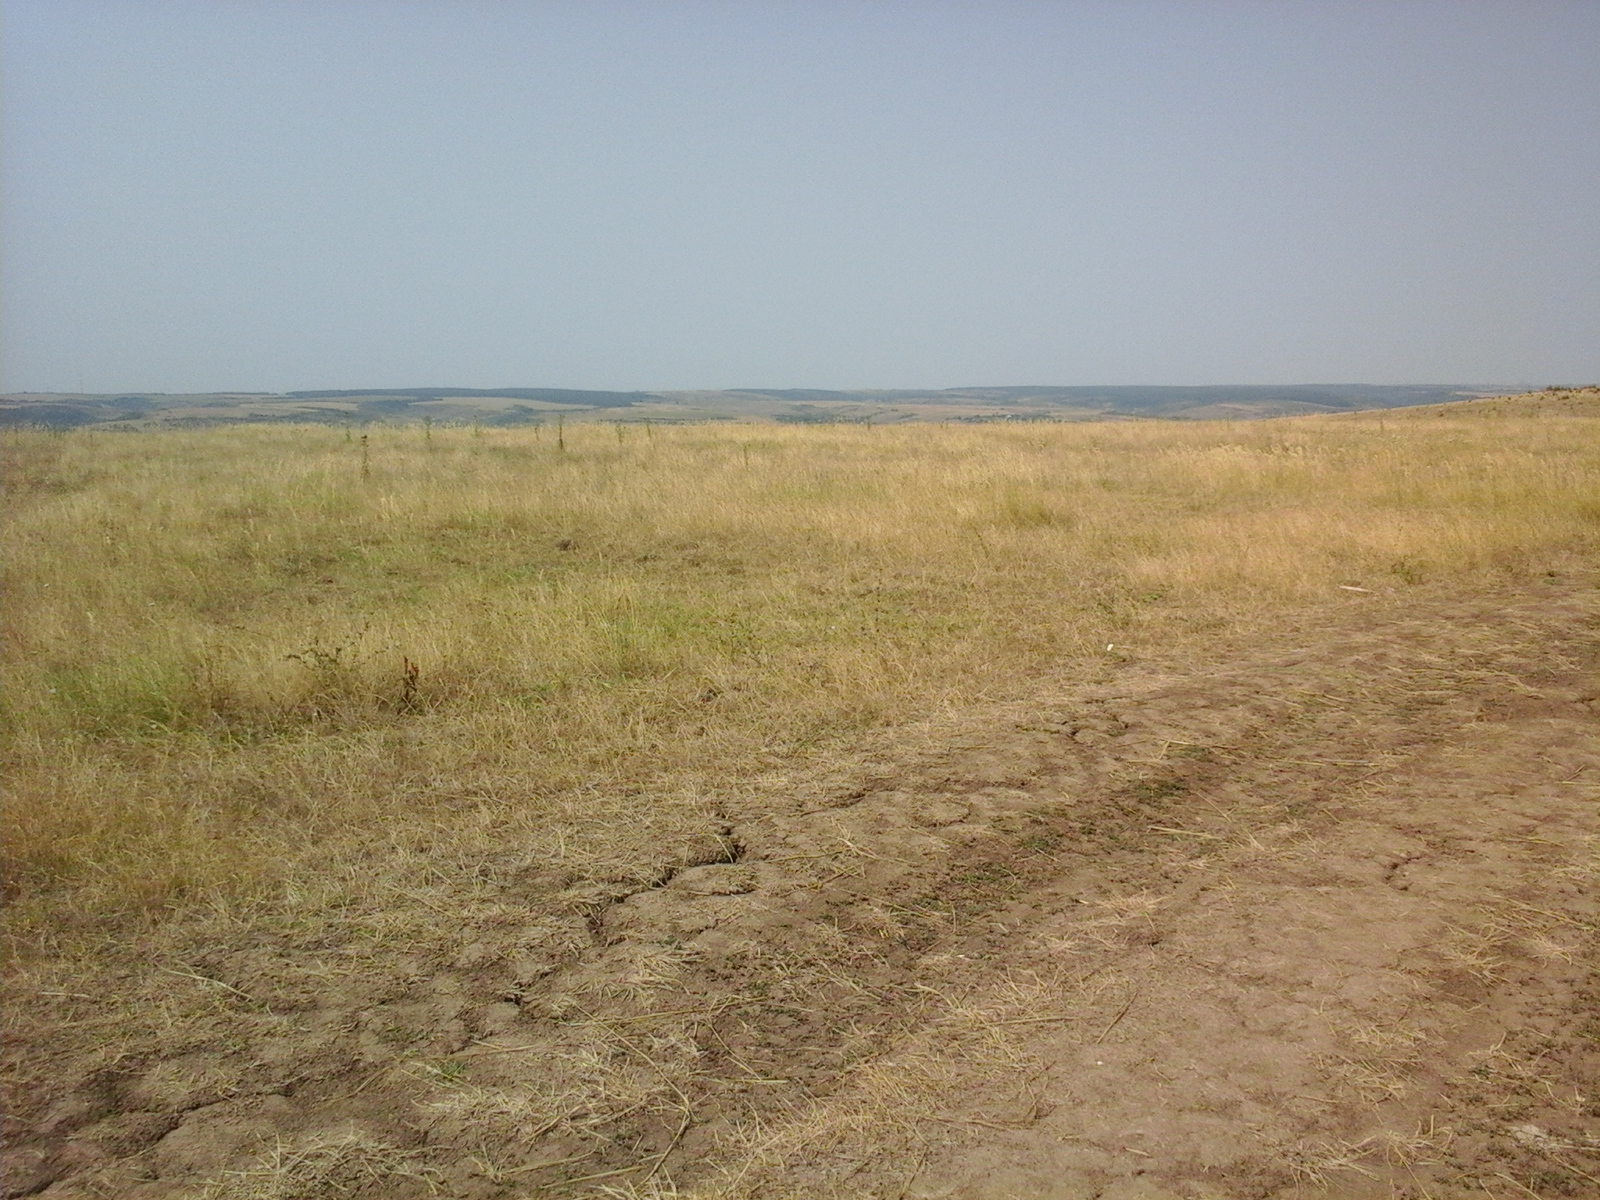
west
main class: Cropland
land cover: Sunflower
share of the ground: > 75 %
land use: Agriculture (excluding fallow land and kitchen gardens)
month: August
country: RO
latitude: 44.4866
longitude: 23.7762
